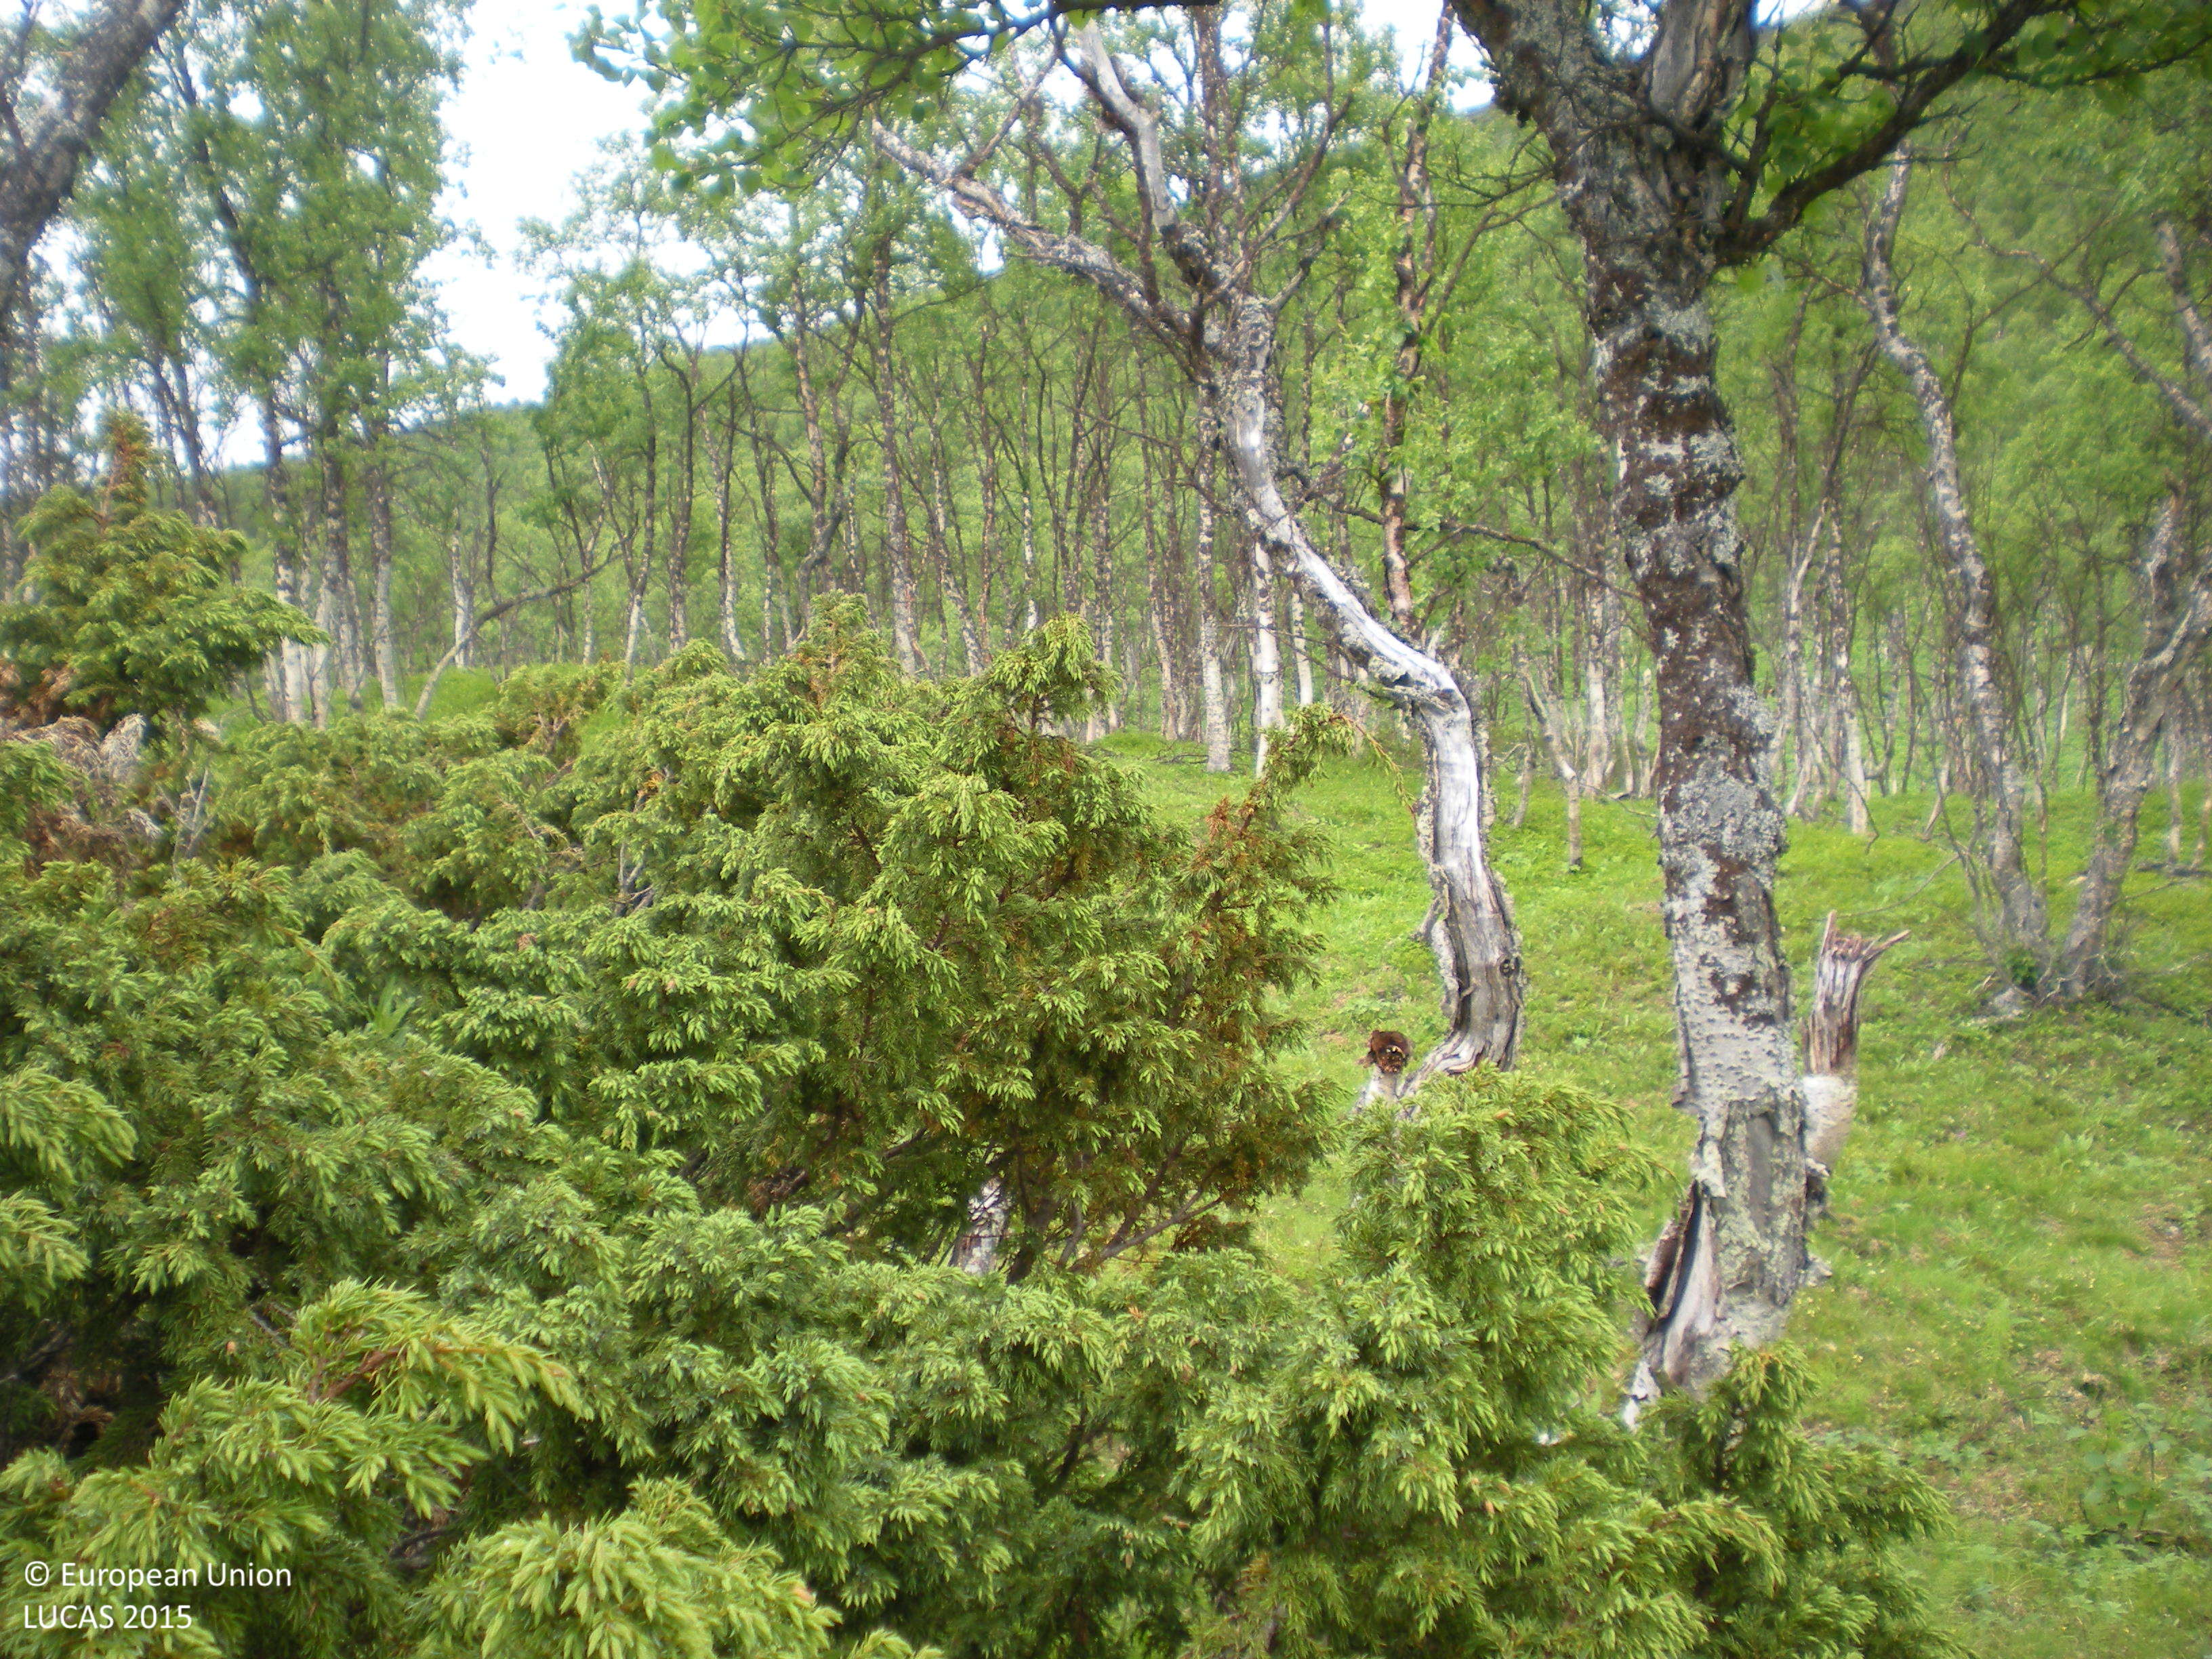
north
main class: Woodland
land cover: Broadleaved woodland
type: boreal forest
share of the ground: 25 - 50 %
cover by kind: broadleaved forest trees 50 %, herbaceous plants 30 %, shrubs 20 %
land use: Semi-natural and natural areas not in use
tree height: < 5 m
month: August
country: SE
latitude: 66.6933
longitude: 16.0928
